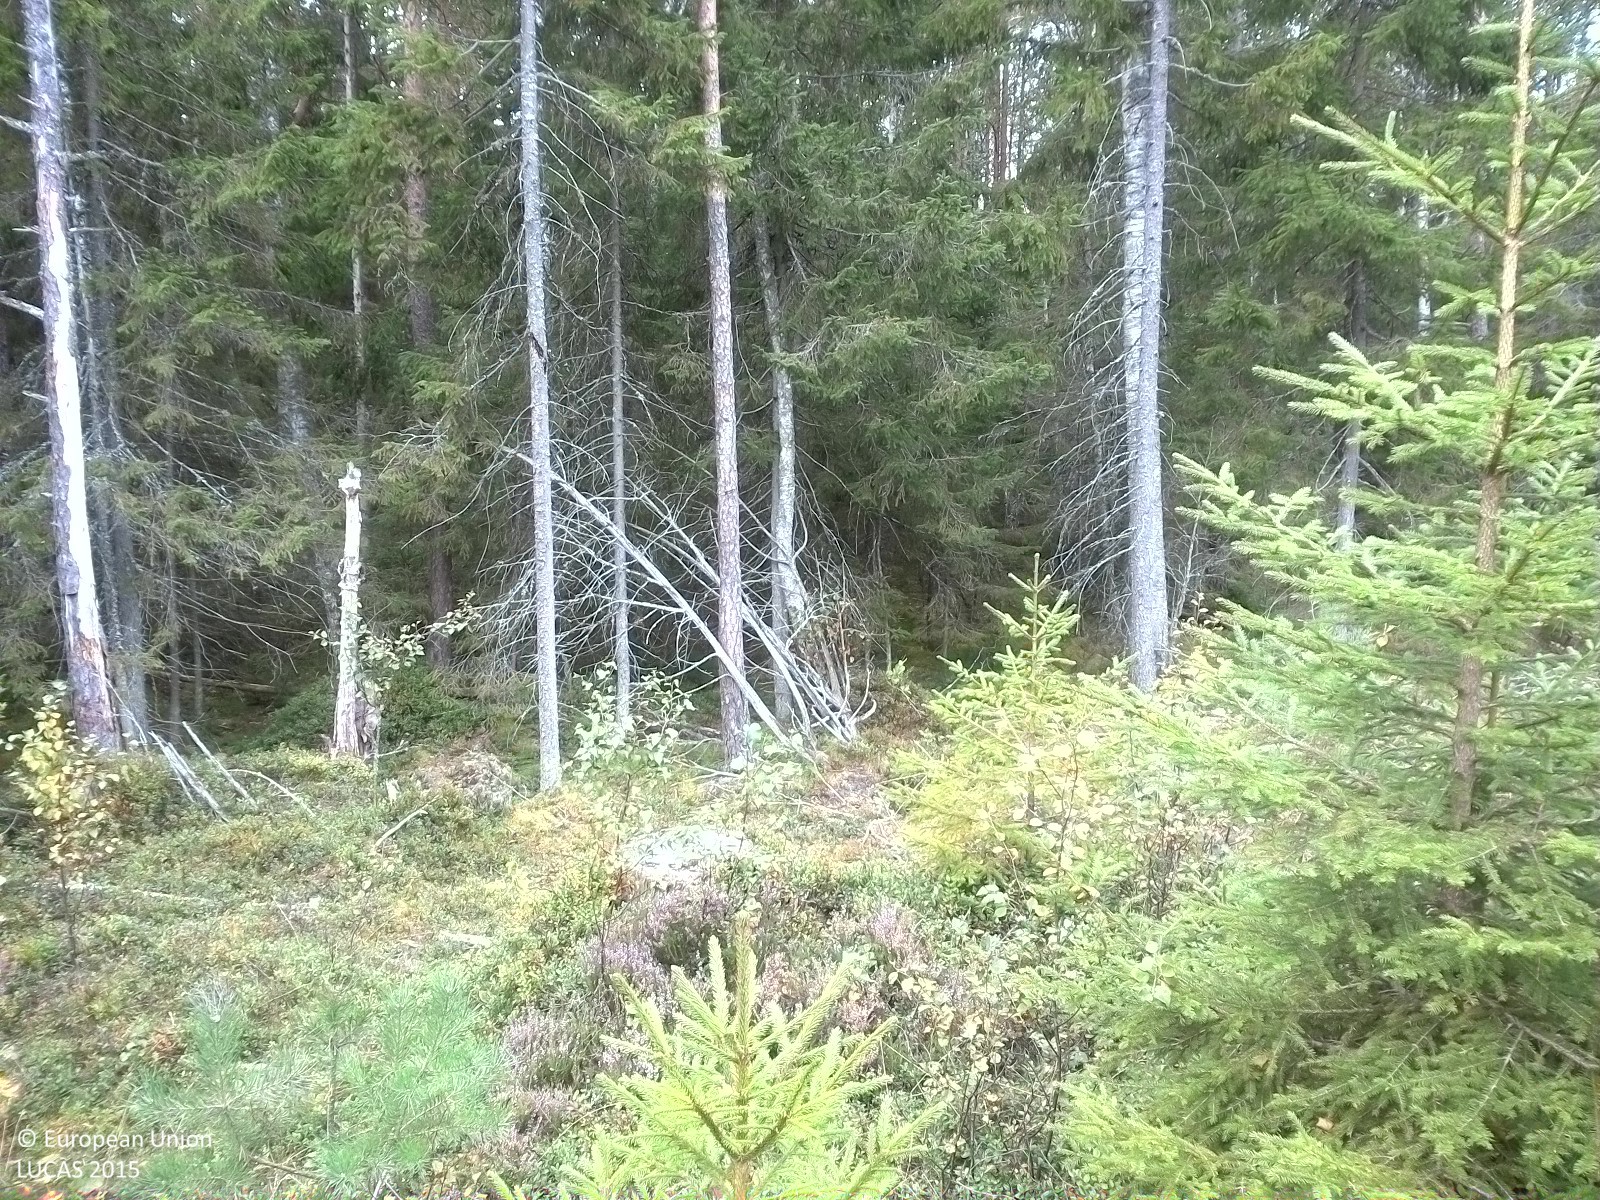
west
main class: Woodland
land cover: Spruce dominated mixed woodland
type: boreal forest
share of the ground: 50 - 75 %
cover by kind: coniferous forest trees 35 %, broadleaved forest trees 25 %, herbaceous plants 20 %, shrubs 10 %, lichens and mosses 10 %
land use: Forestry
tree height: < 5 m
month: August
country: SE
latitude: 59.3539
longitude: 15.8841
